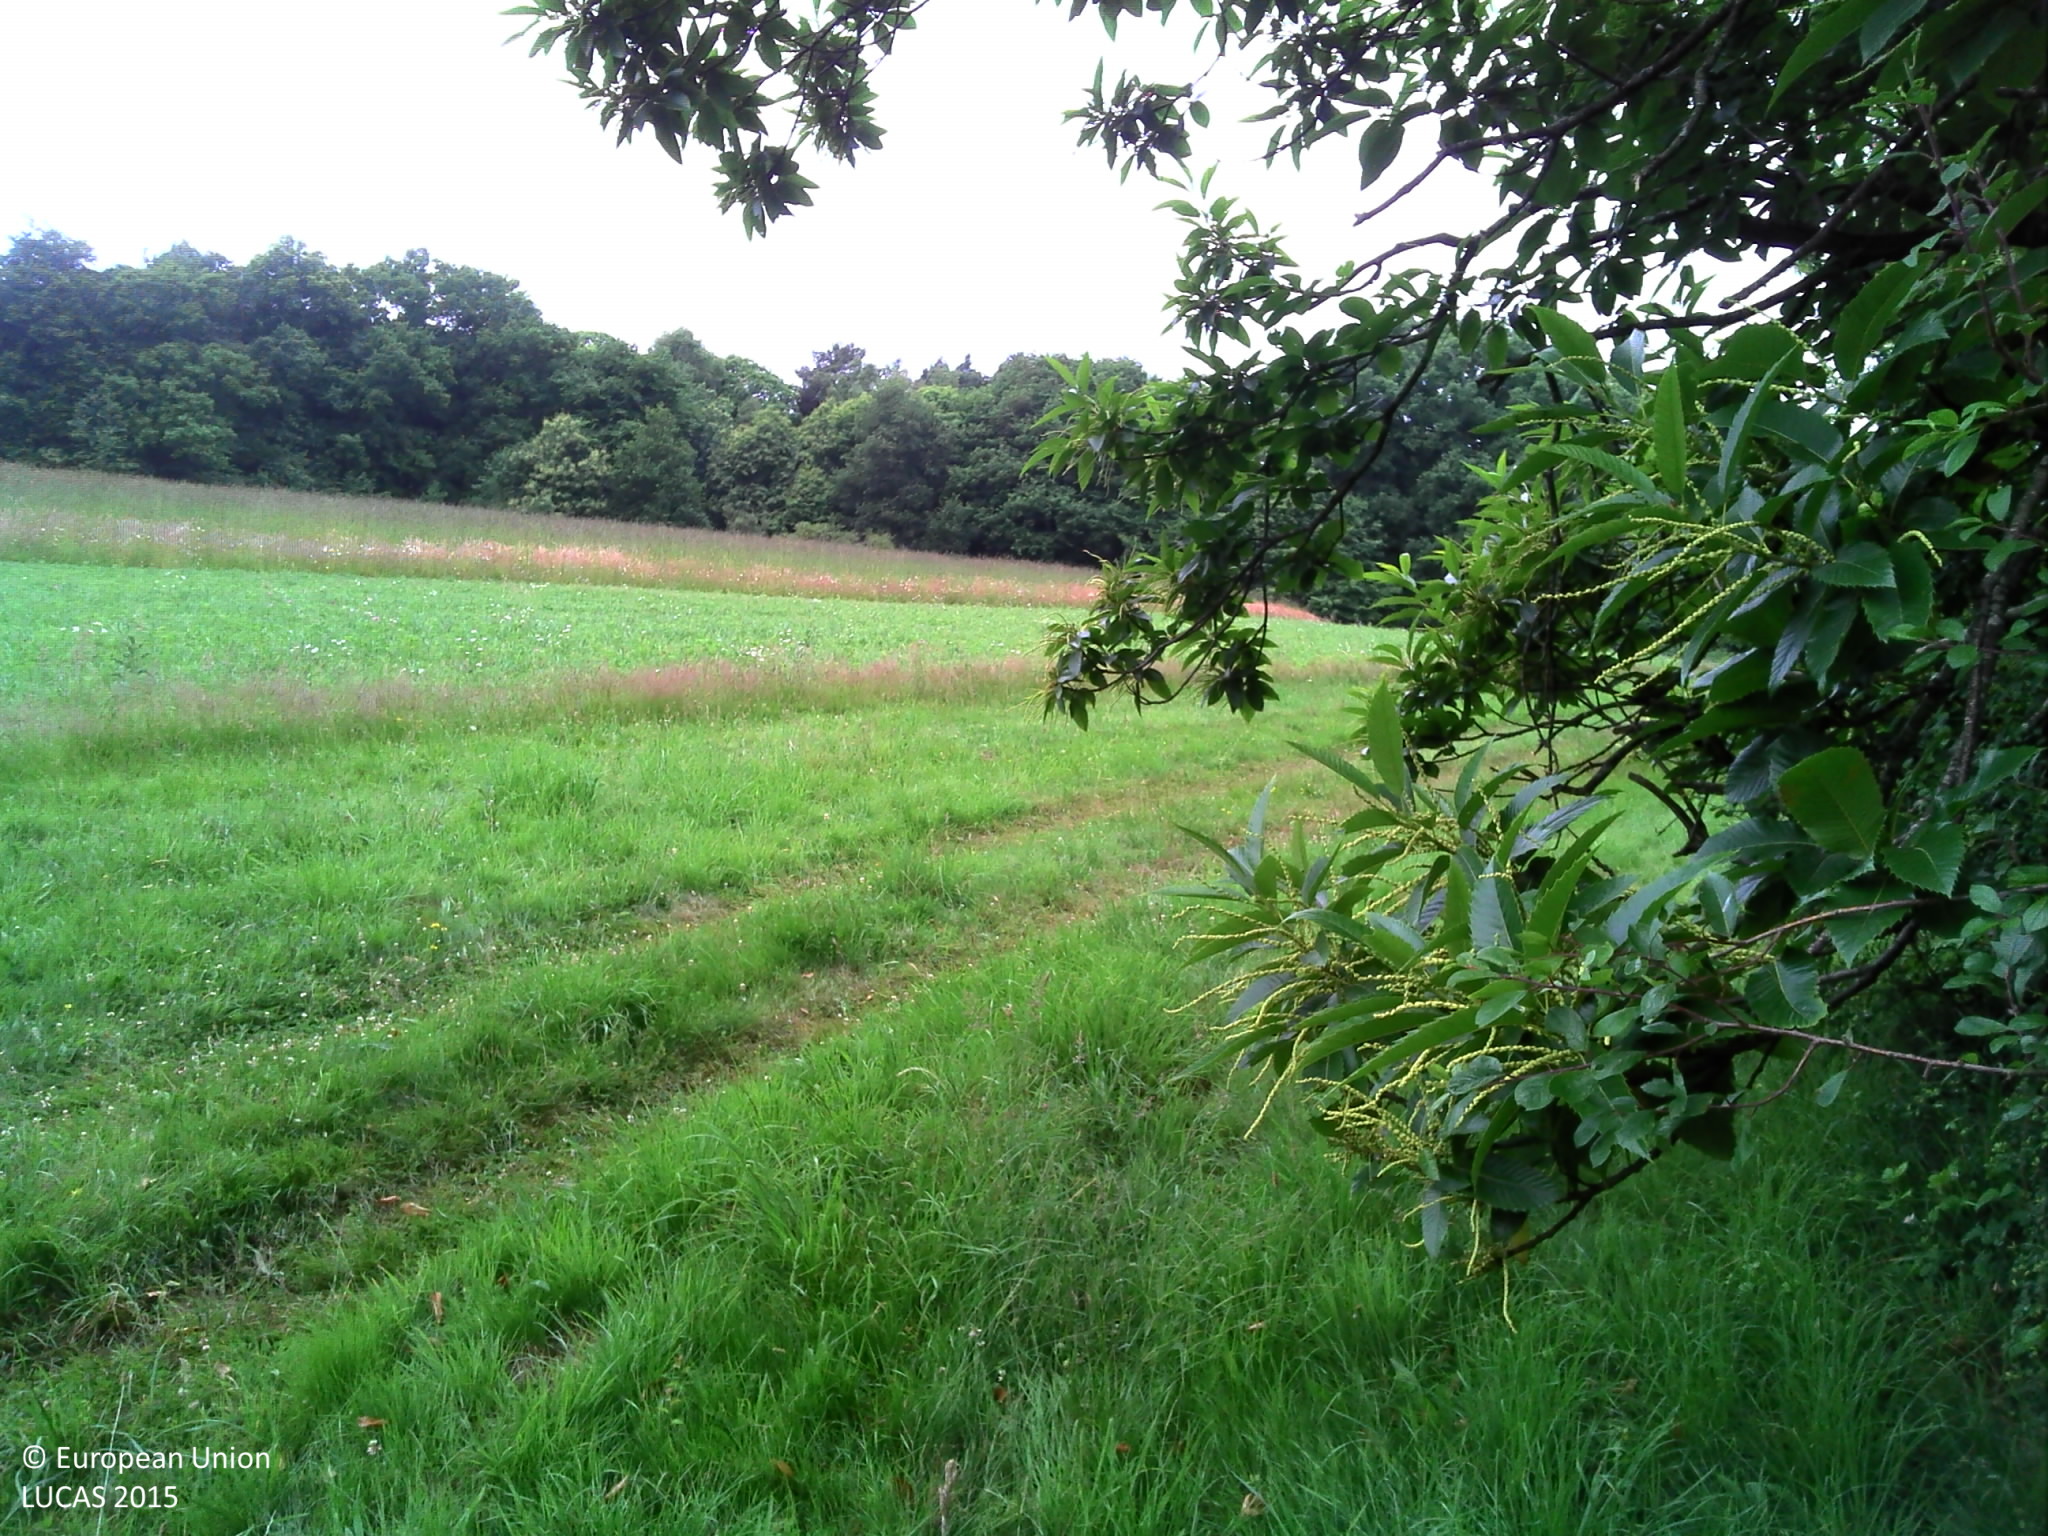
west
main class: Woodland
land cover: Broadleaved woodland
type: acidophilous oak and oak-birch forest
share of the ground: > 75 %
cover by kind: broadleaved forest trees 90 %, herbaceous plants 10 %
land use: Forestry
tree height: > 5 m
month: June
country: FR
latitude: 47.9604
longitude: -1.7126
